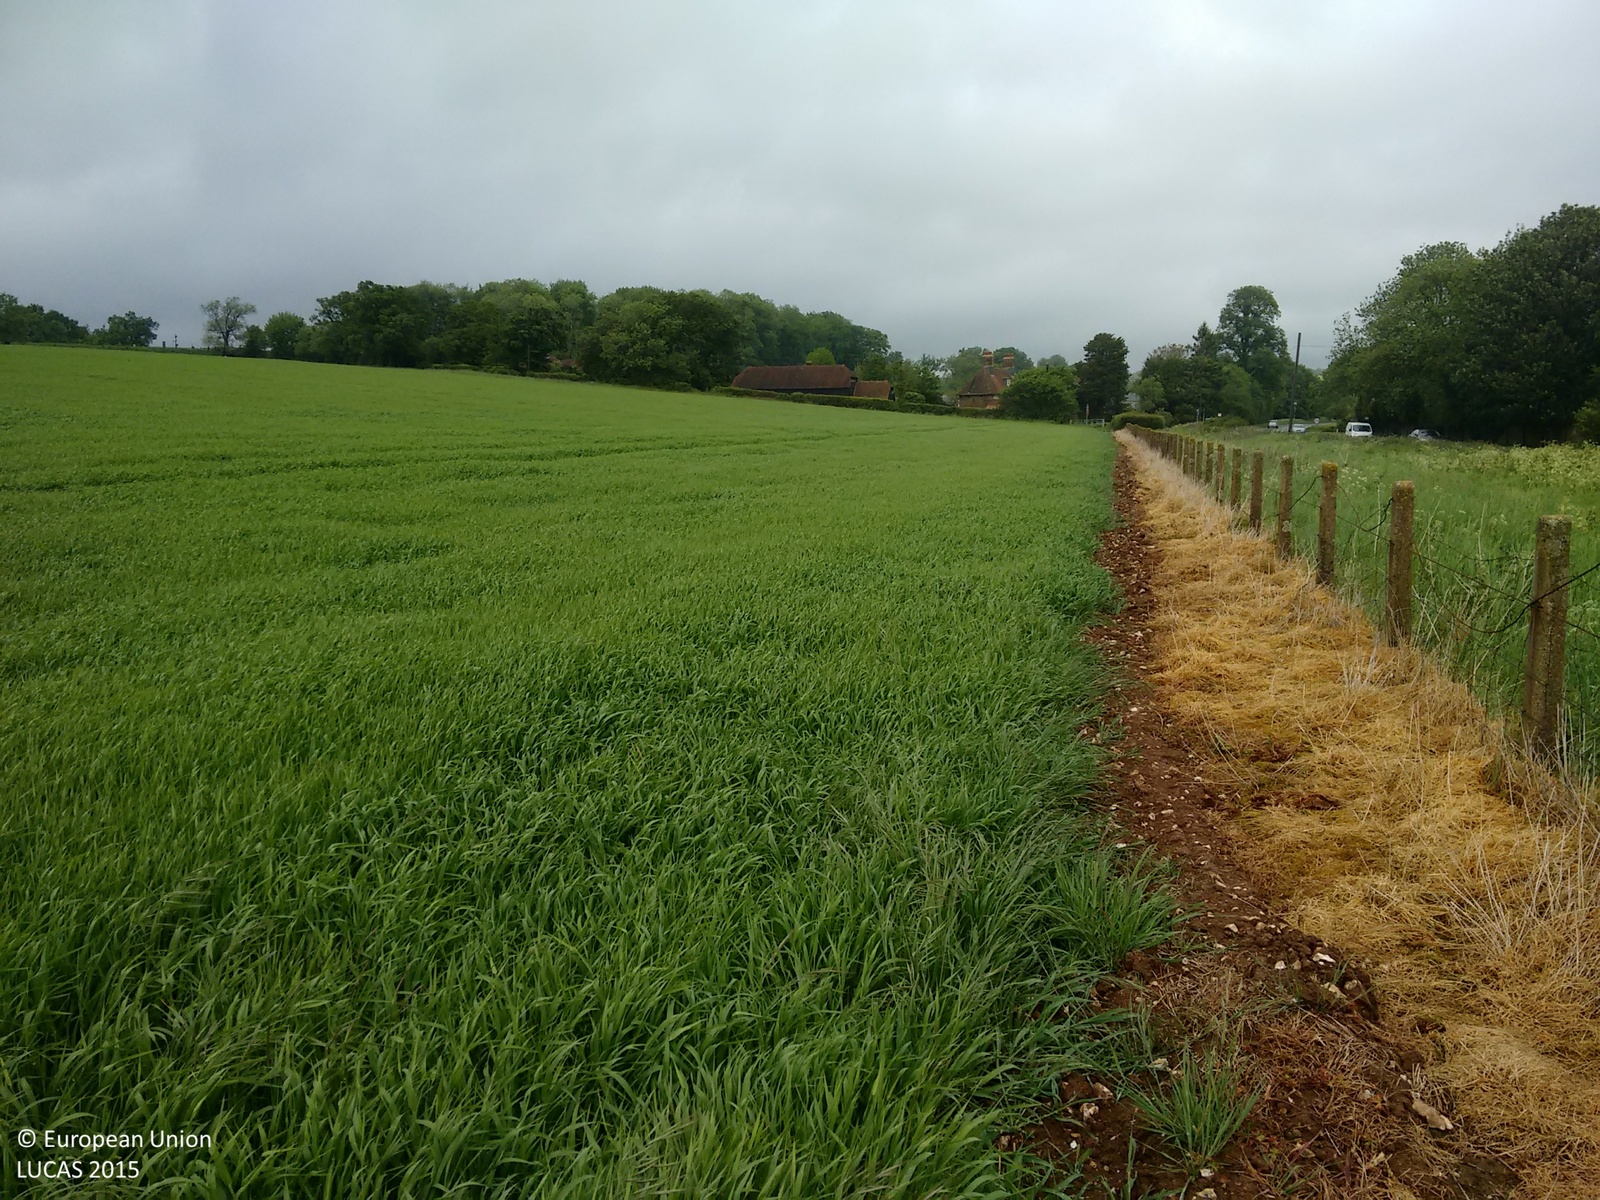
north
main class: Cropland
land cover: Barley
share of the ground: > 75 %
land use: Agriculture (excluding fallow land and kitchen gardens)
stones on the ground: 10 - 25 %
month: June
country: GB
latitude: 51.0943
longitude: -1.0830
